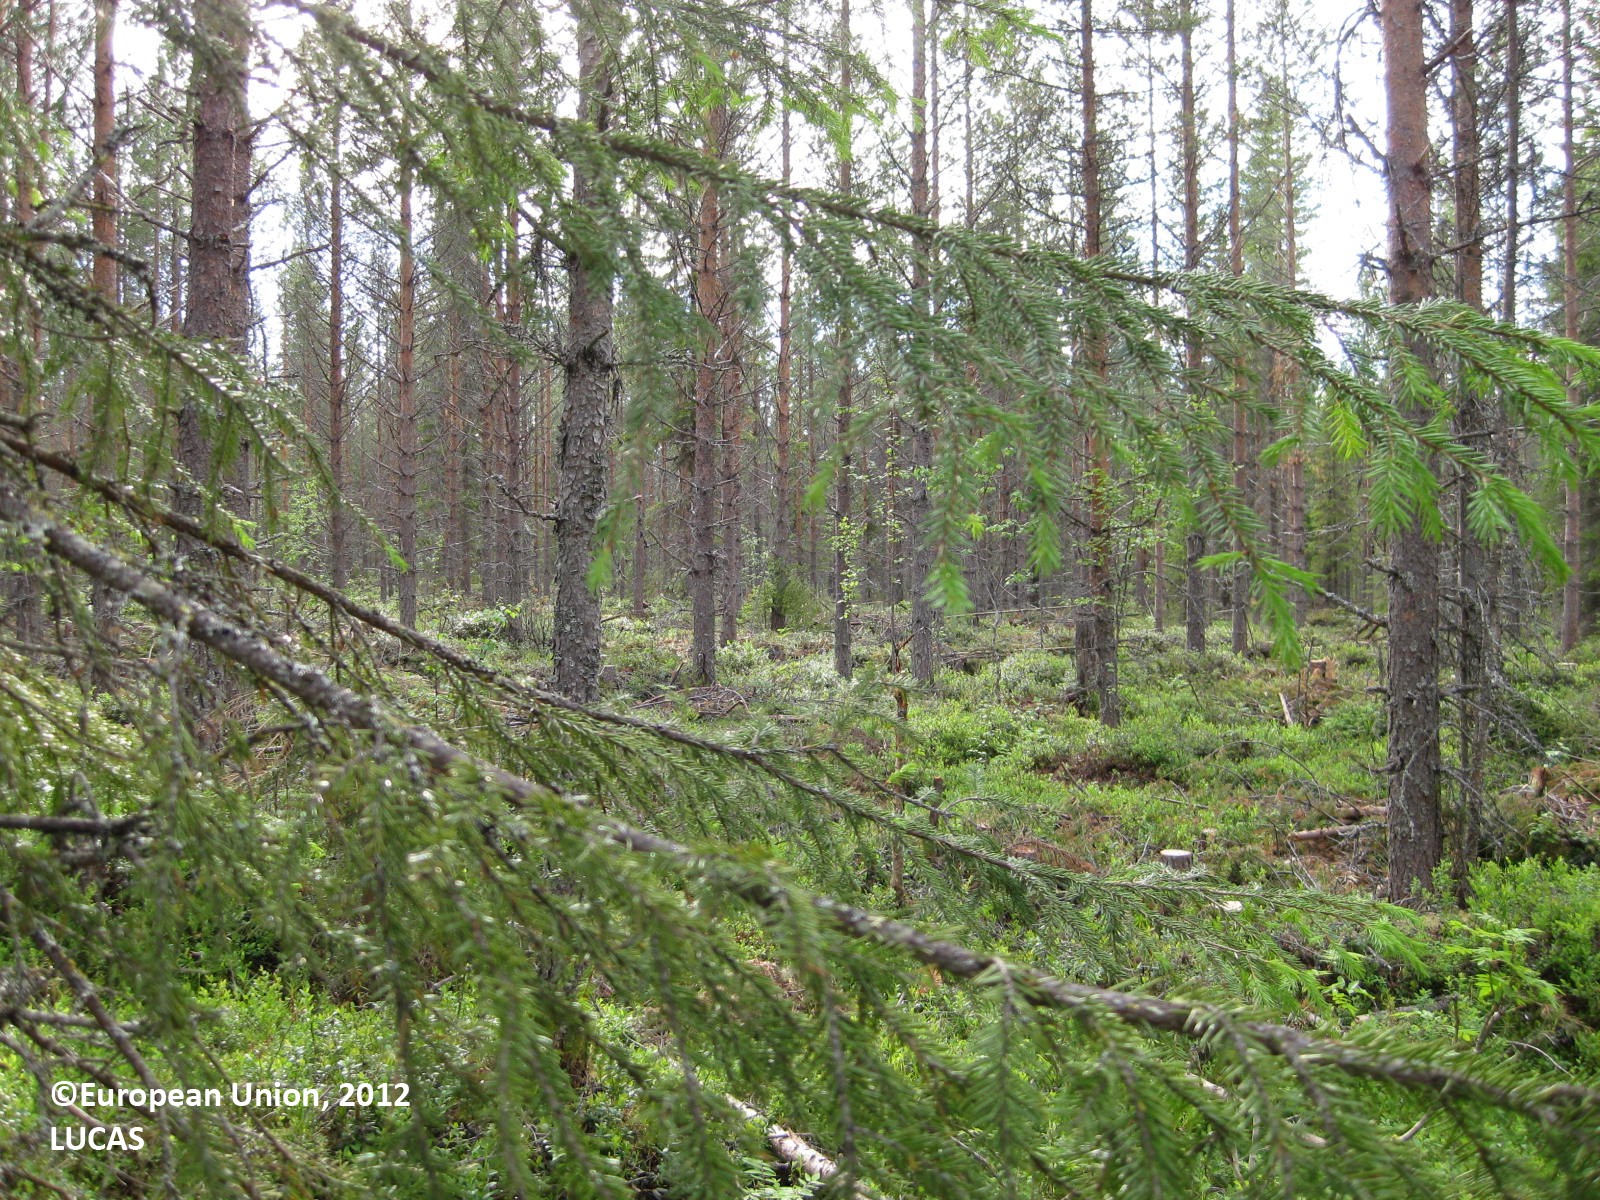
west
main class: Woodland
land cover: Pine dominated coniferous woodland
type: boreal forest
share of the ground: > 75 %
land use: Forestry
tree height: > 5 m
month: June
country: FI
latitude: 65.2750
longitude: 28.1741
